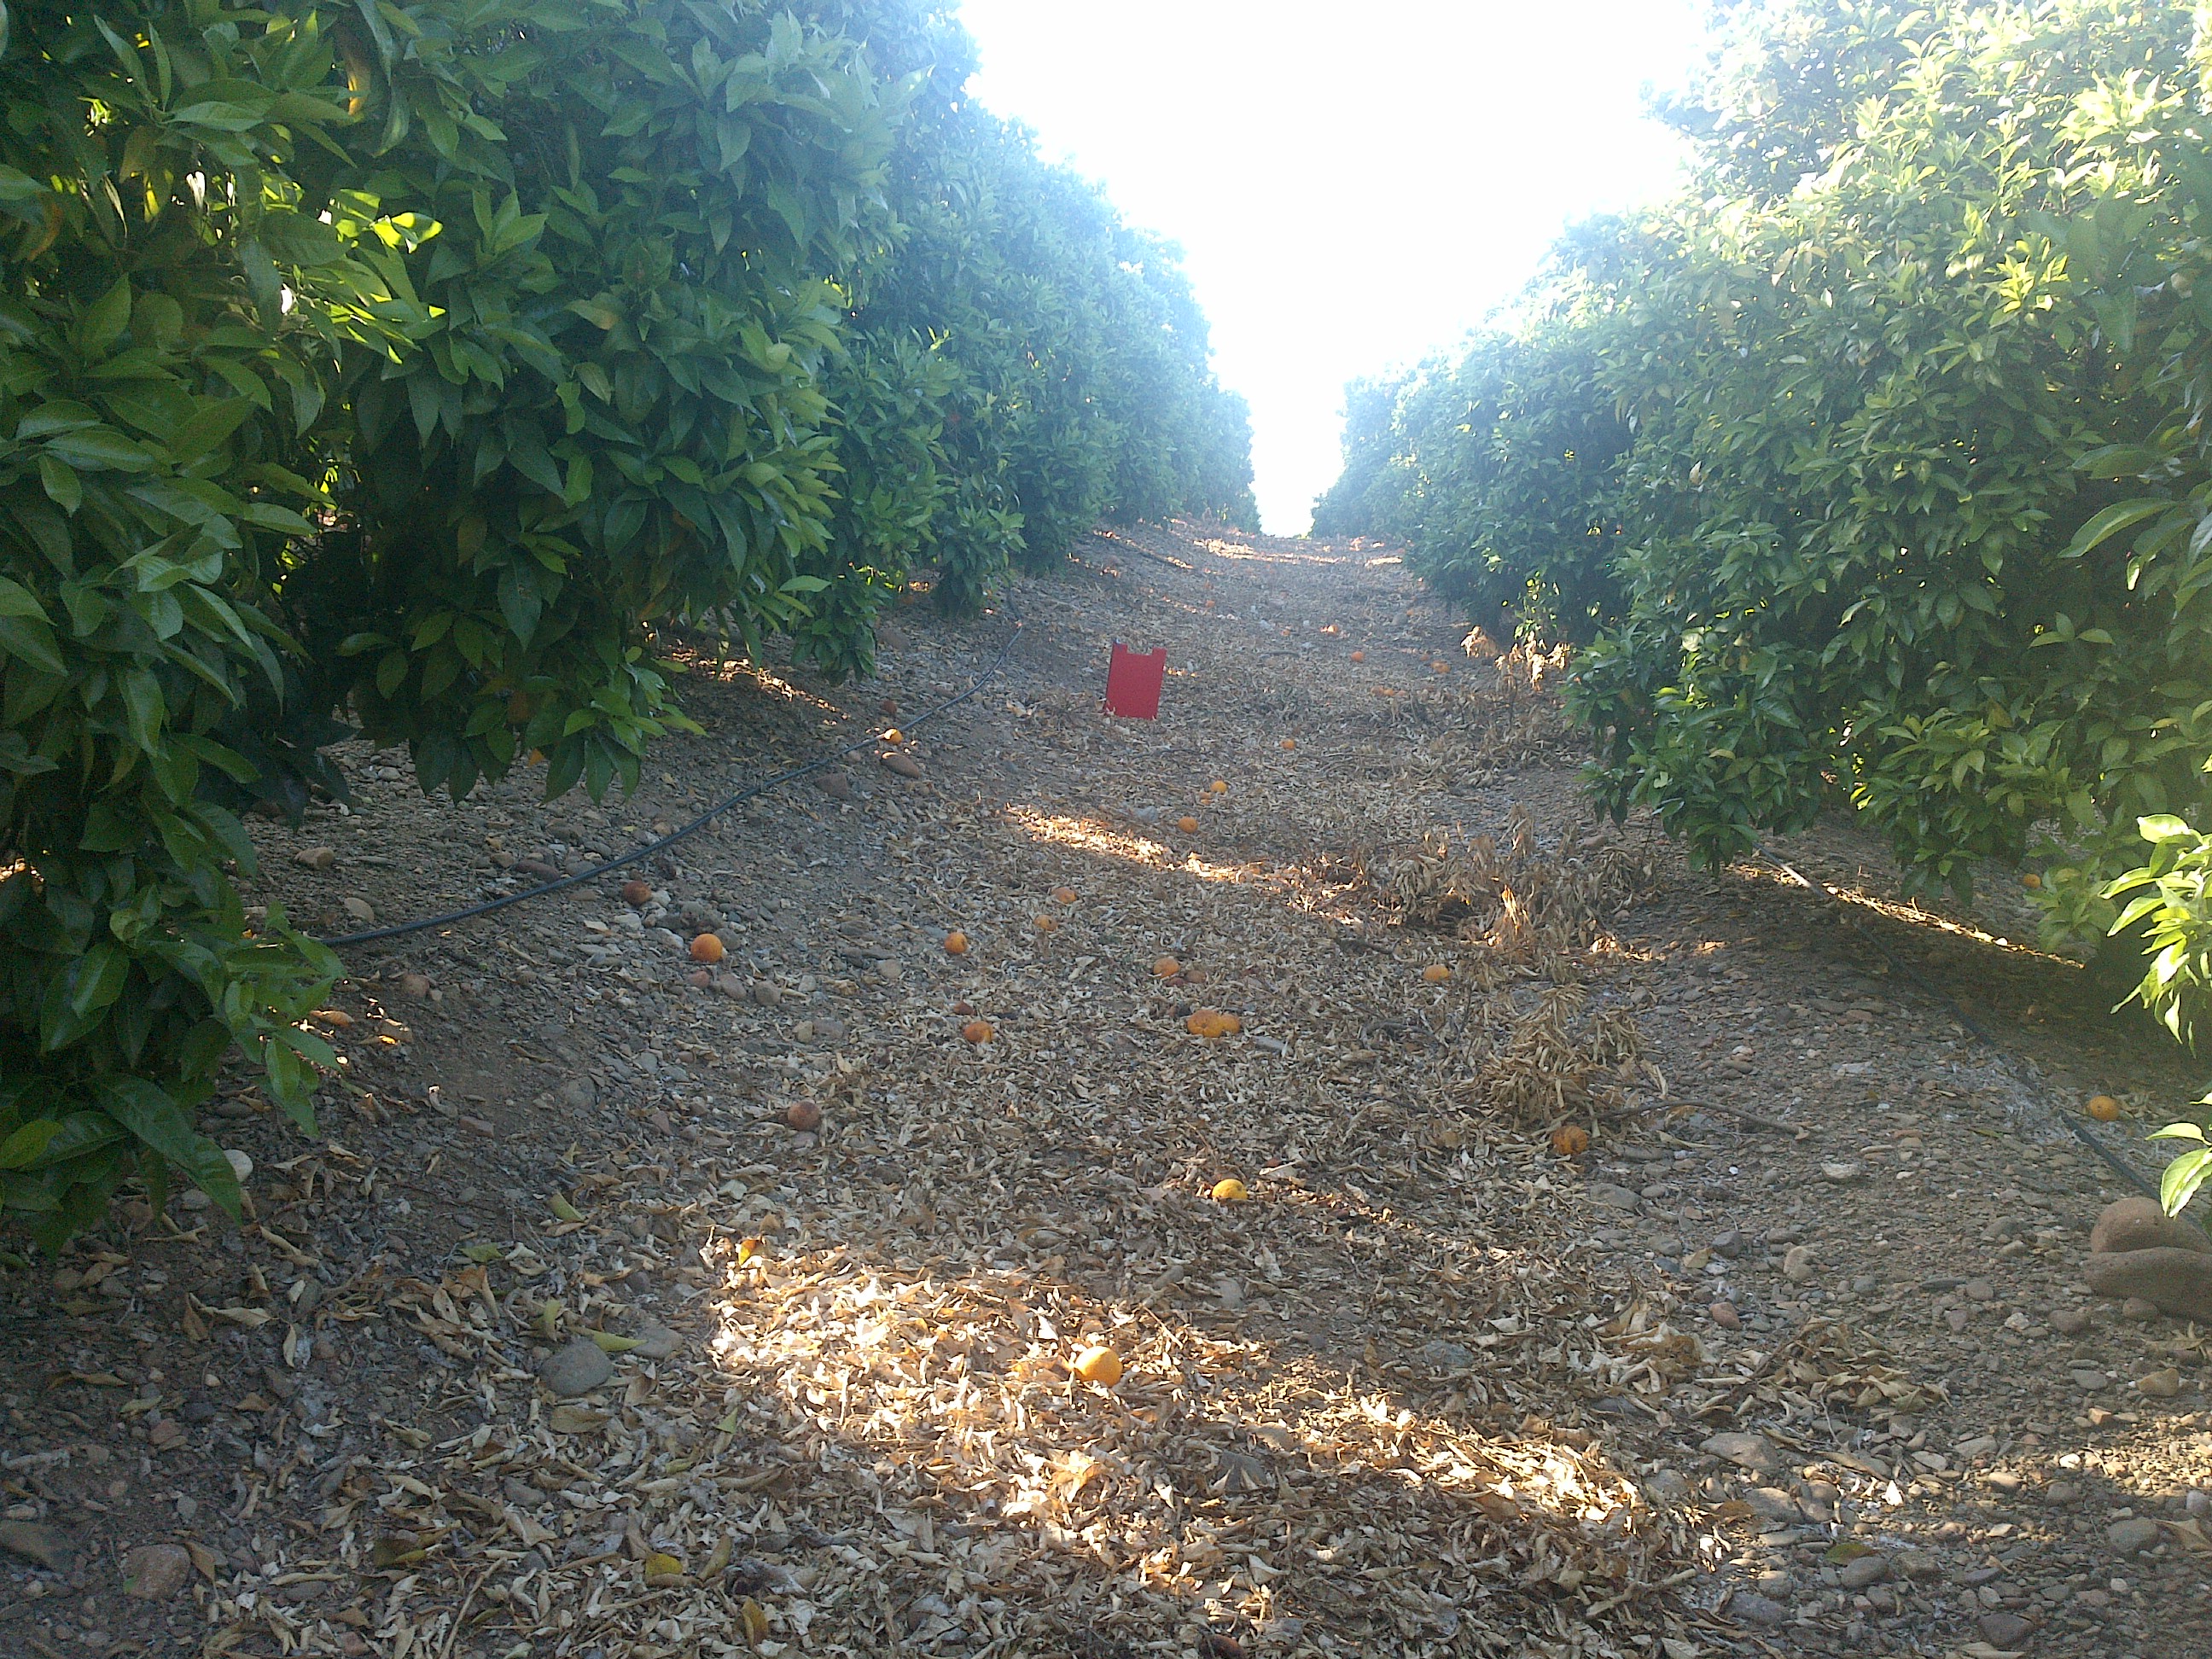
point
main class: Cropland
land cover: Oranges
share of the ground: > 75 %
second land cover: Other bare soil
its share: > 75 %
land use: Agriculture (excluding fallow land and kitchen gardens)
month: May
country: ES
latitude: 37.8021
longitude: -5.2270
